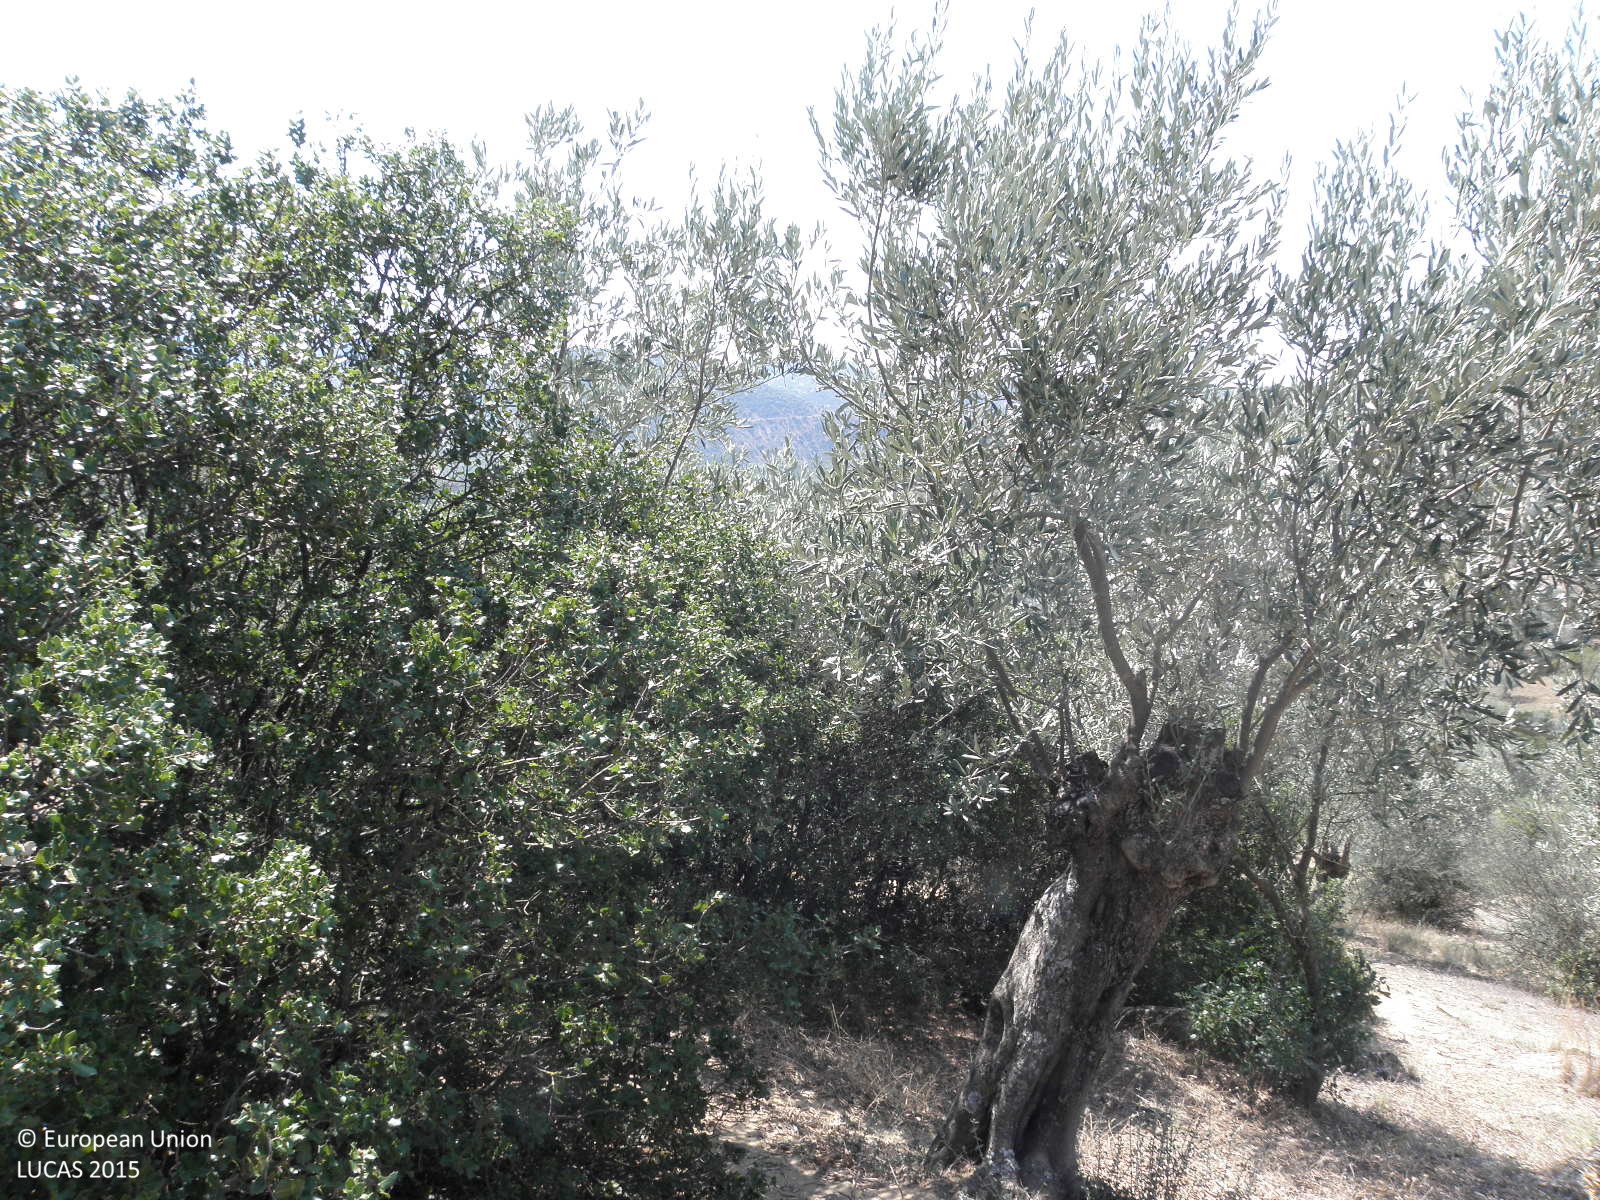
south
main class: Cropland
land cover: Olive groves
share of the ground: 25 - 50 %
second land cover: Spontaneously vegetated surfaces
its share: > 75 %
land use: Agriculture (excluding fallow land and kitchen gardens)
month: August
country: GR
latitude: 39.8382
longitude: 22.4377
